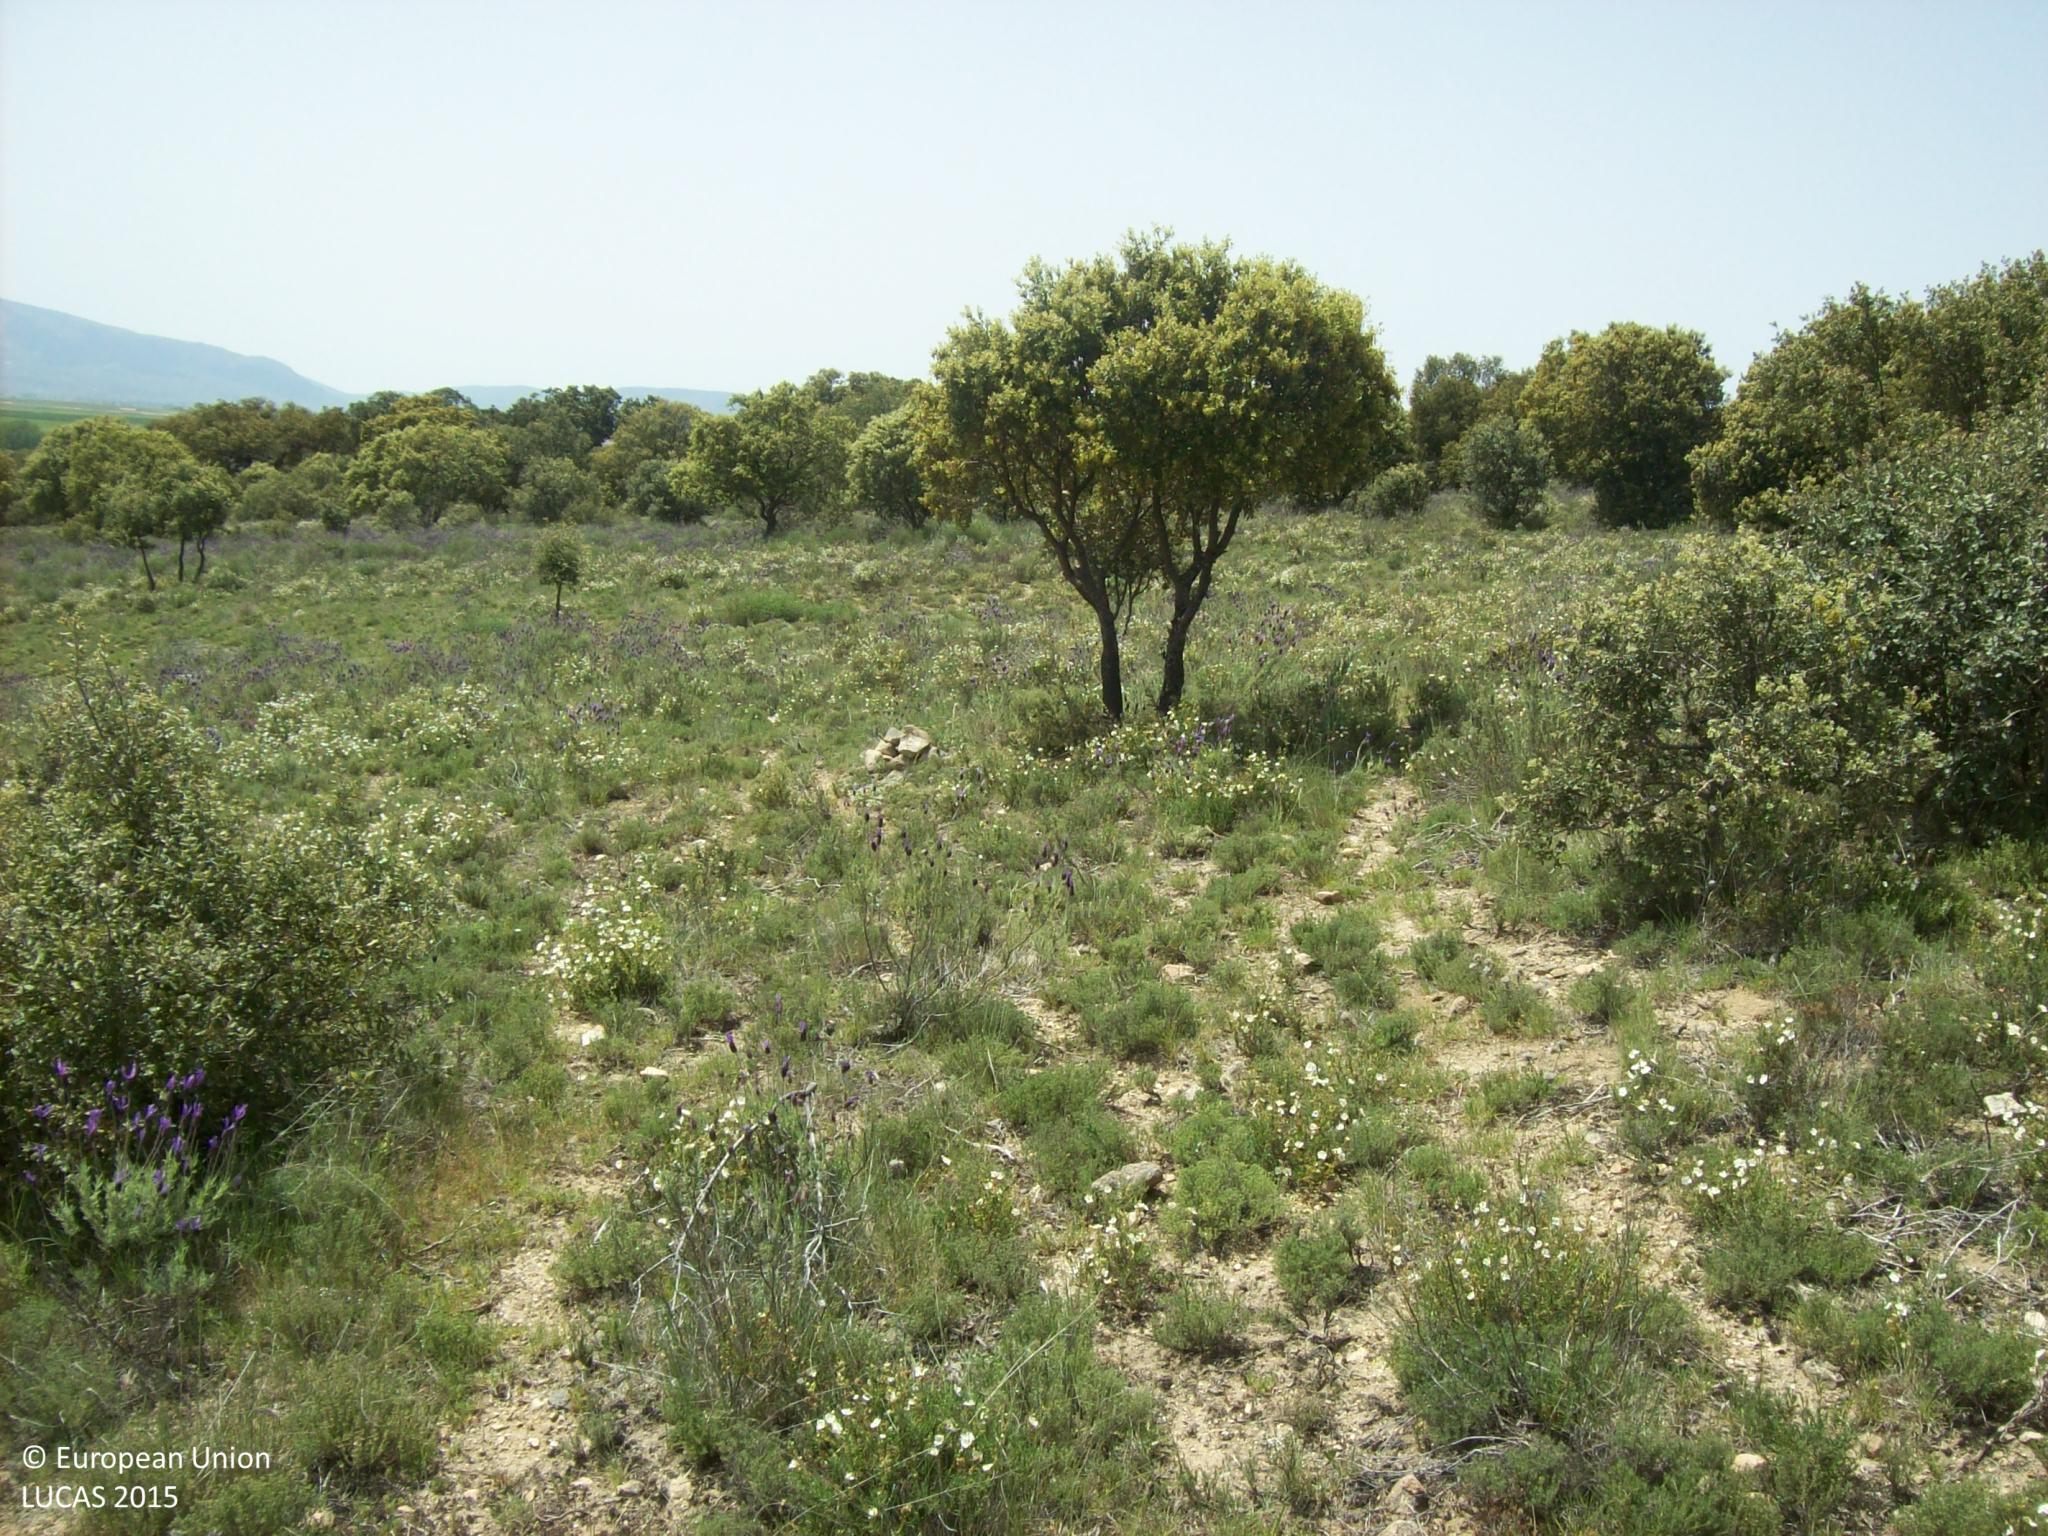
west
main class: Woodland
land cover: Broadleaved woodland
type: broadleaved evergreen forest
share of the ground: 50 - 75 %
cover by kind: shrubs 60 %, unconsolidated bare surface 20 %, broadleaved forest trees 10 %, herbaceous plants 10 %
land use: Semi-natural and natural areas not in use
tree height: < 5 m
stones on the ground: < 10 %
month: May
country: ES
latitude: 40.6072
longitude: -4.9144
